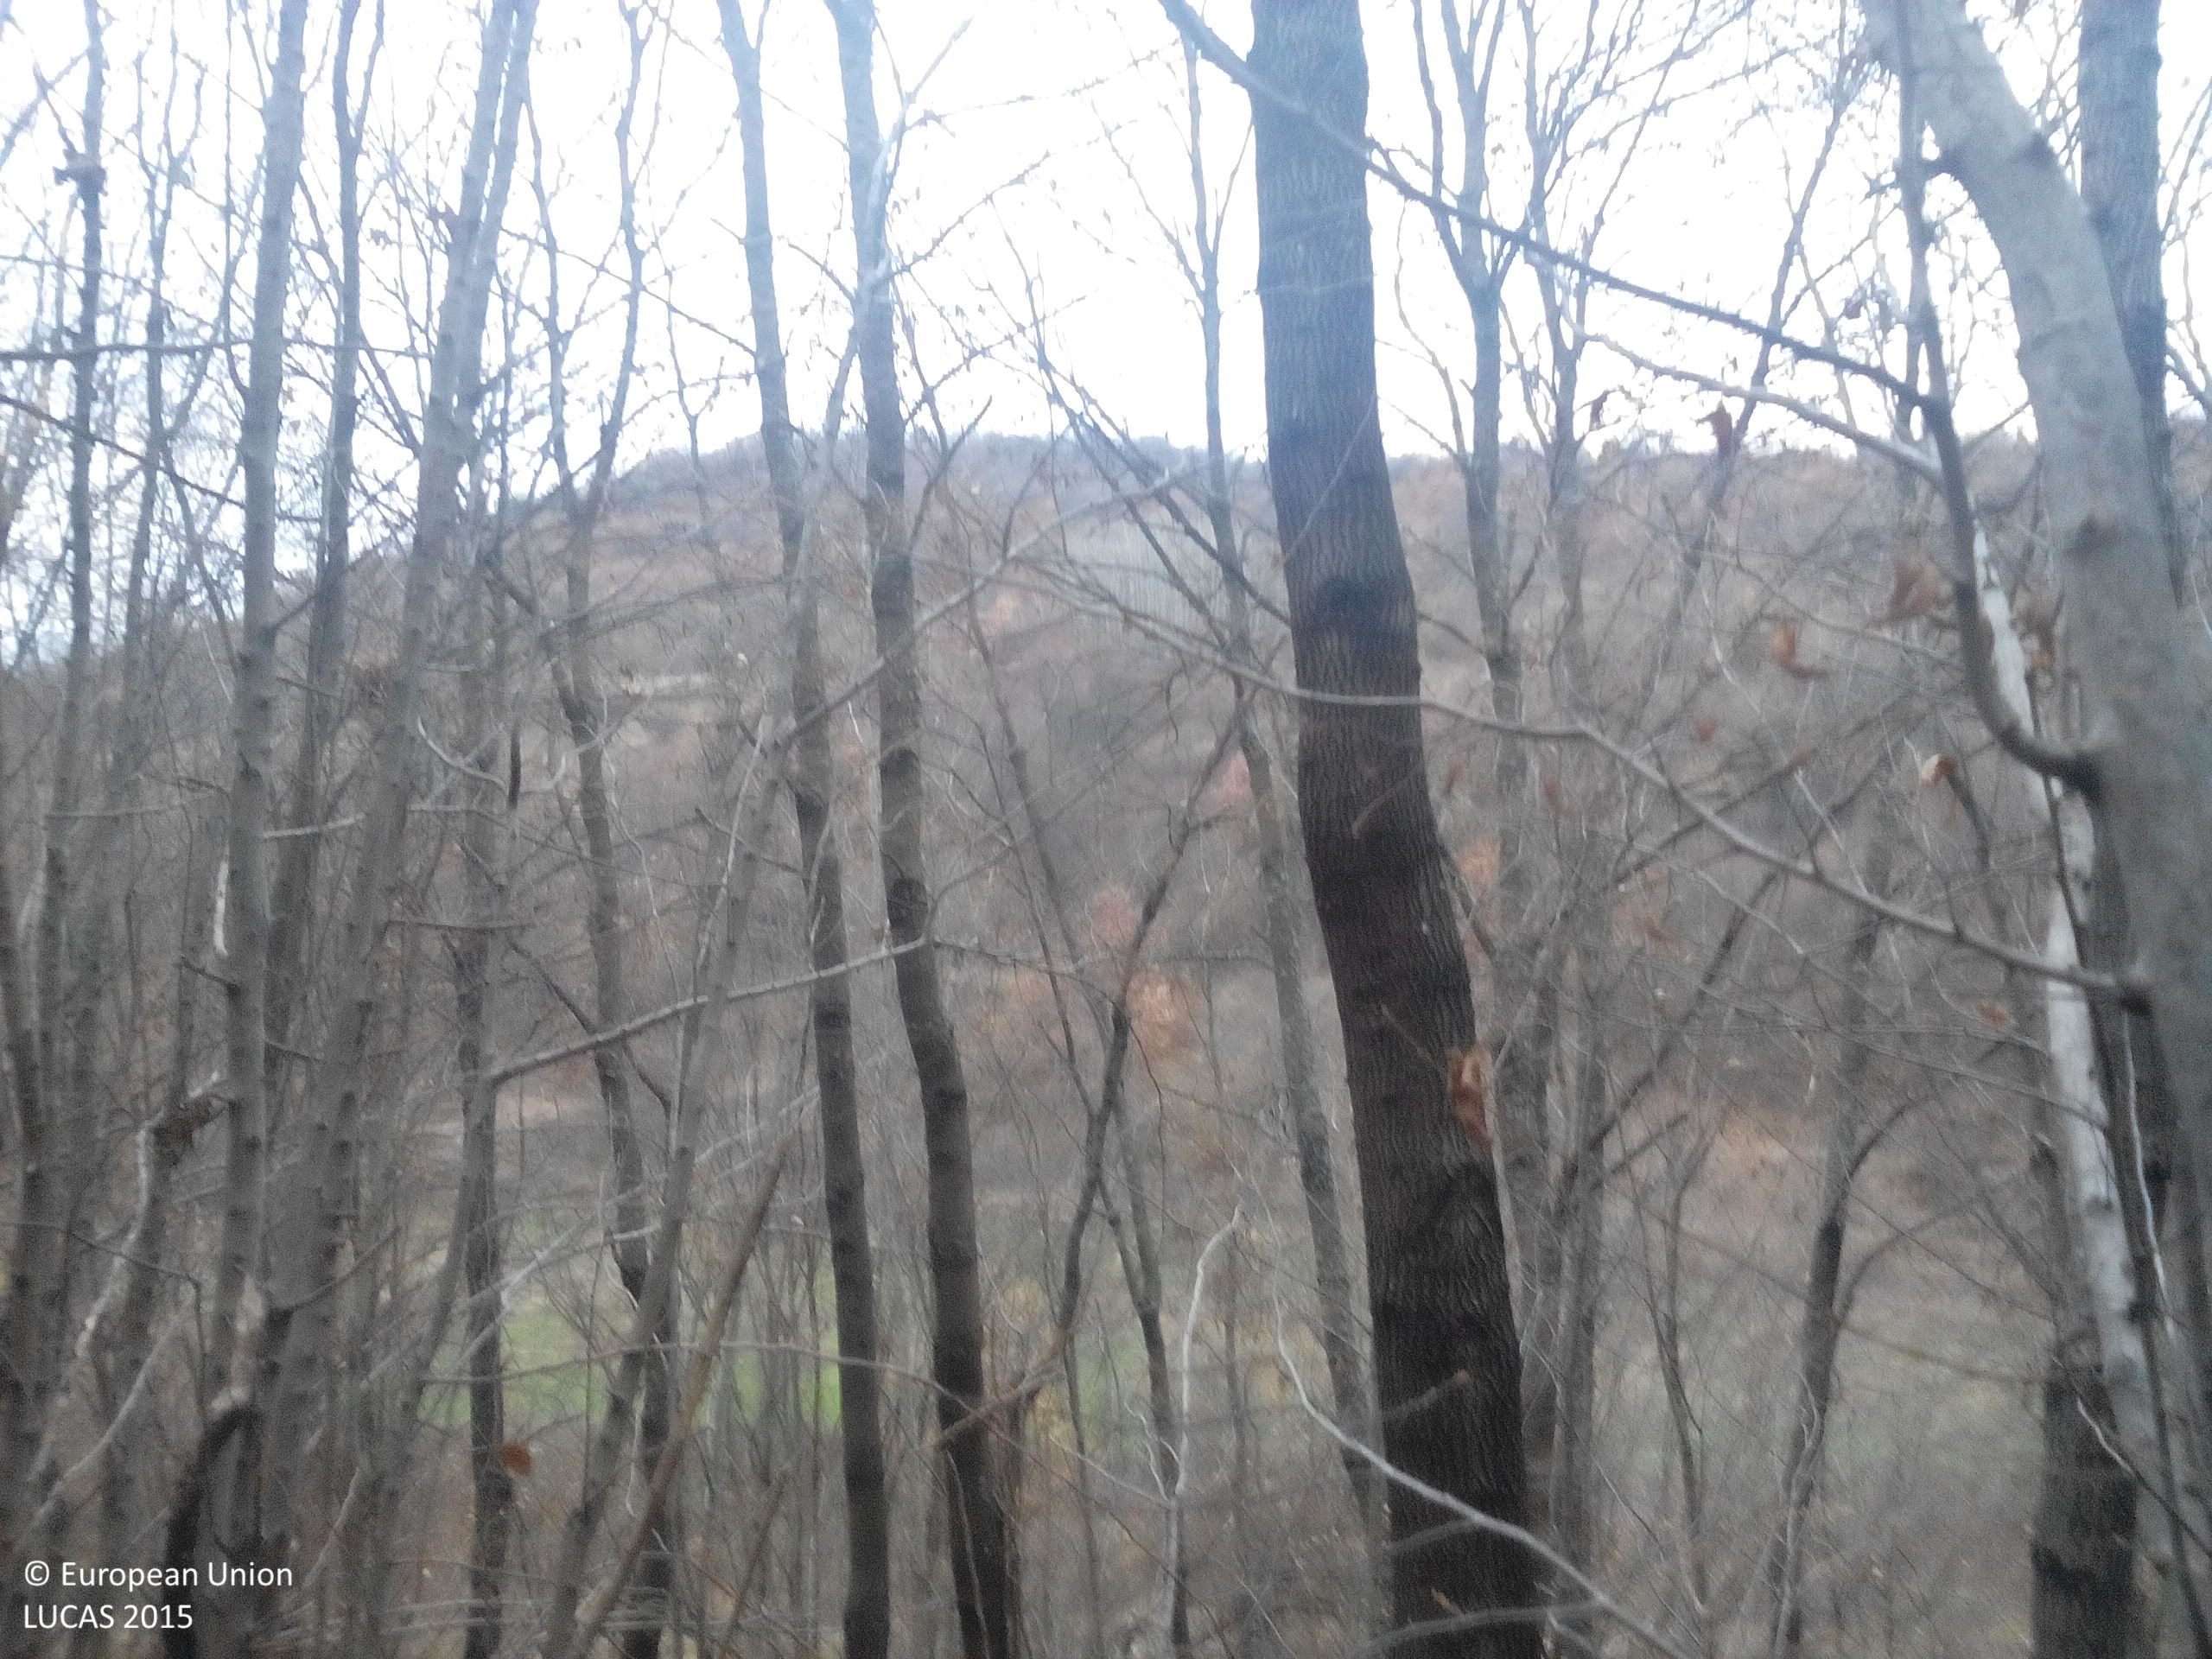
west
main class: Woodland
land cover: Broadleaved woodland
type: mesophytic deciduous forest
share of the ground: > 75 %
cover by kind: broadleaved forest trees 100 %
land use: Forestry
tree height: > 5 m
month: November
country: BG
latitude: 43.0809
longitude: 23.7647
